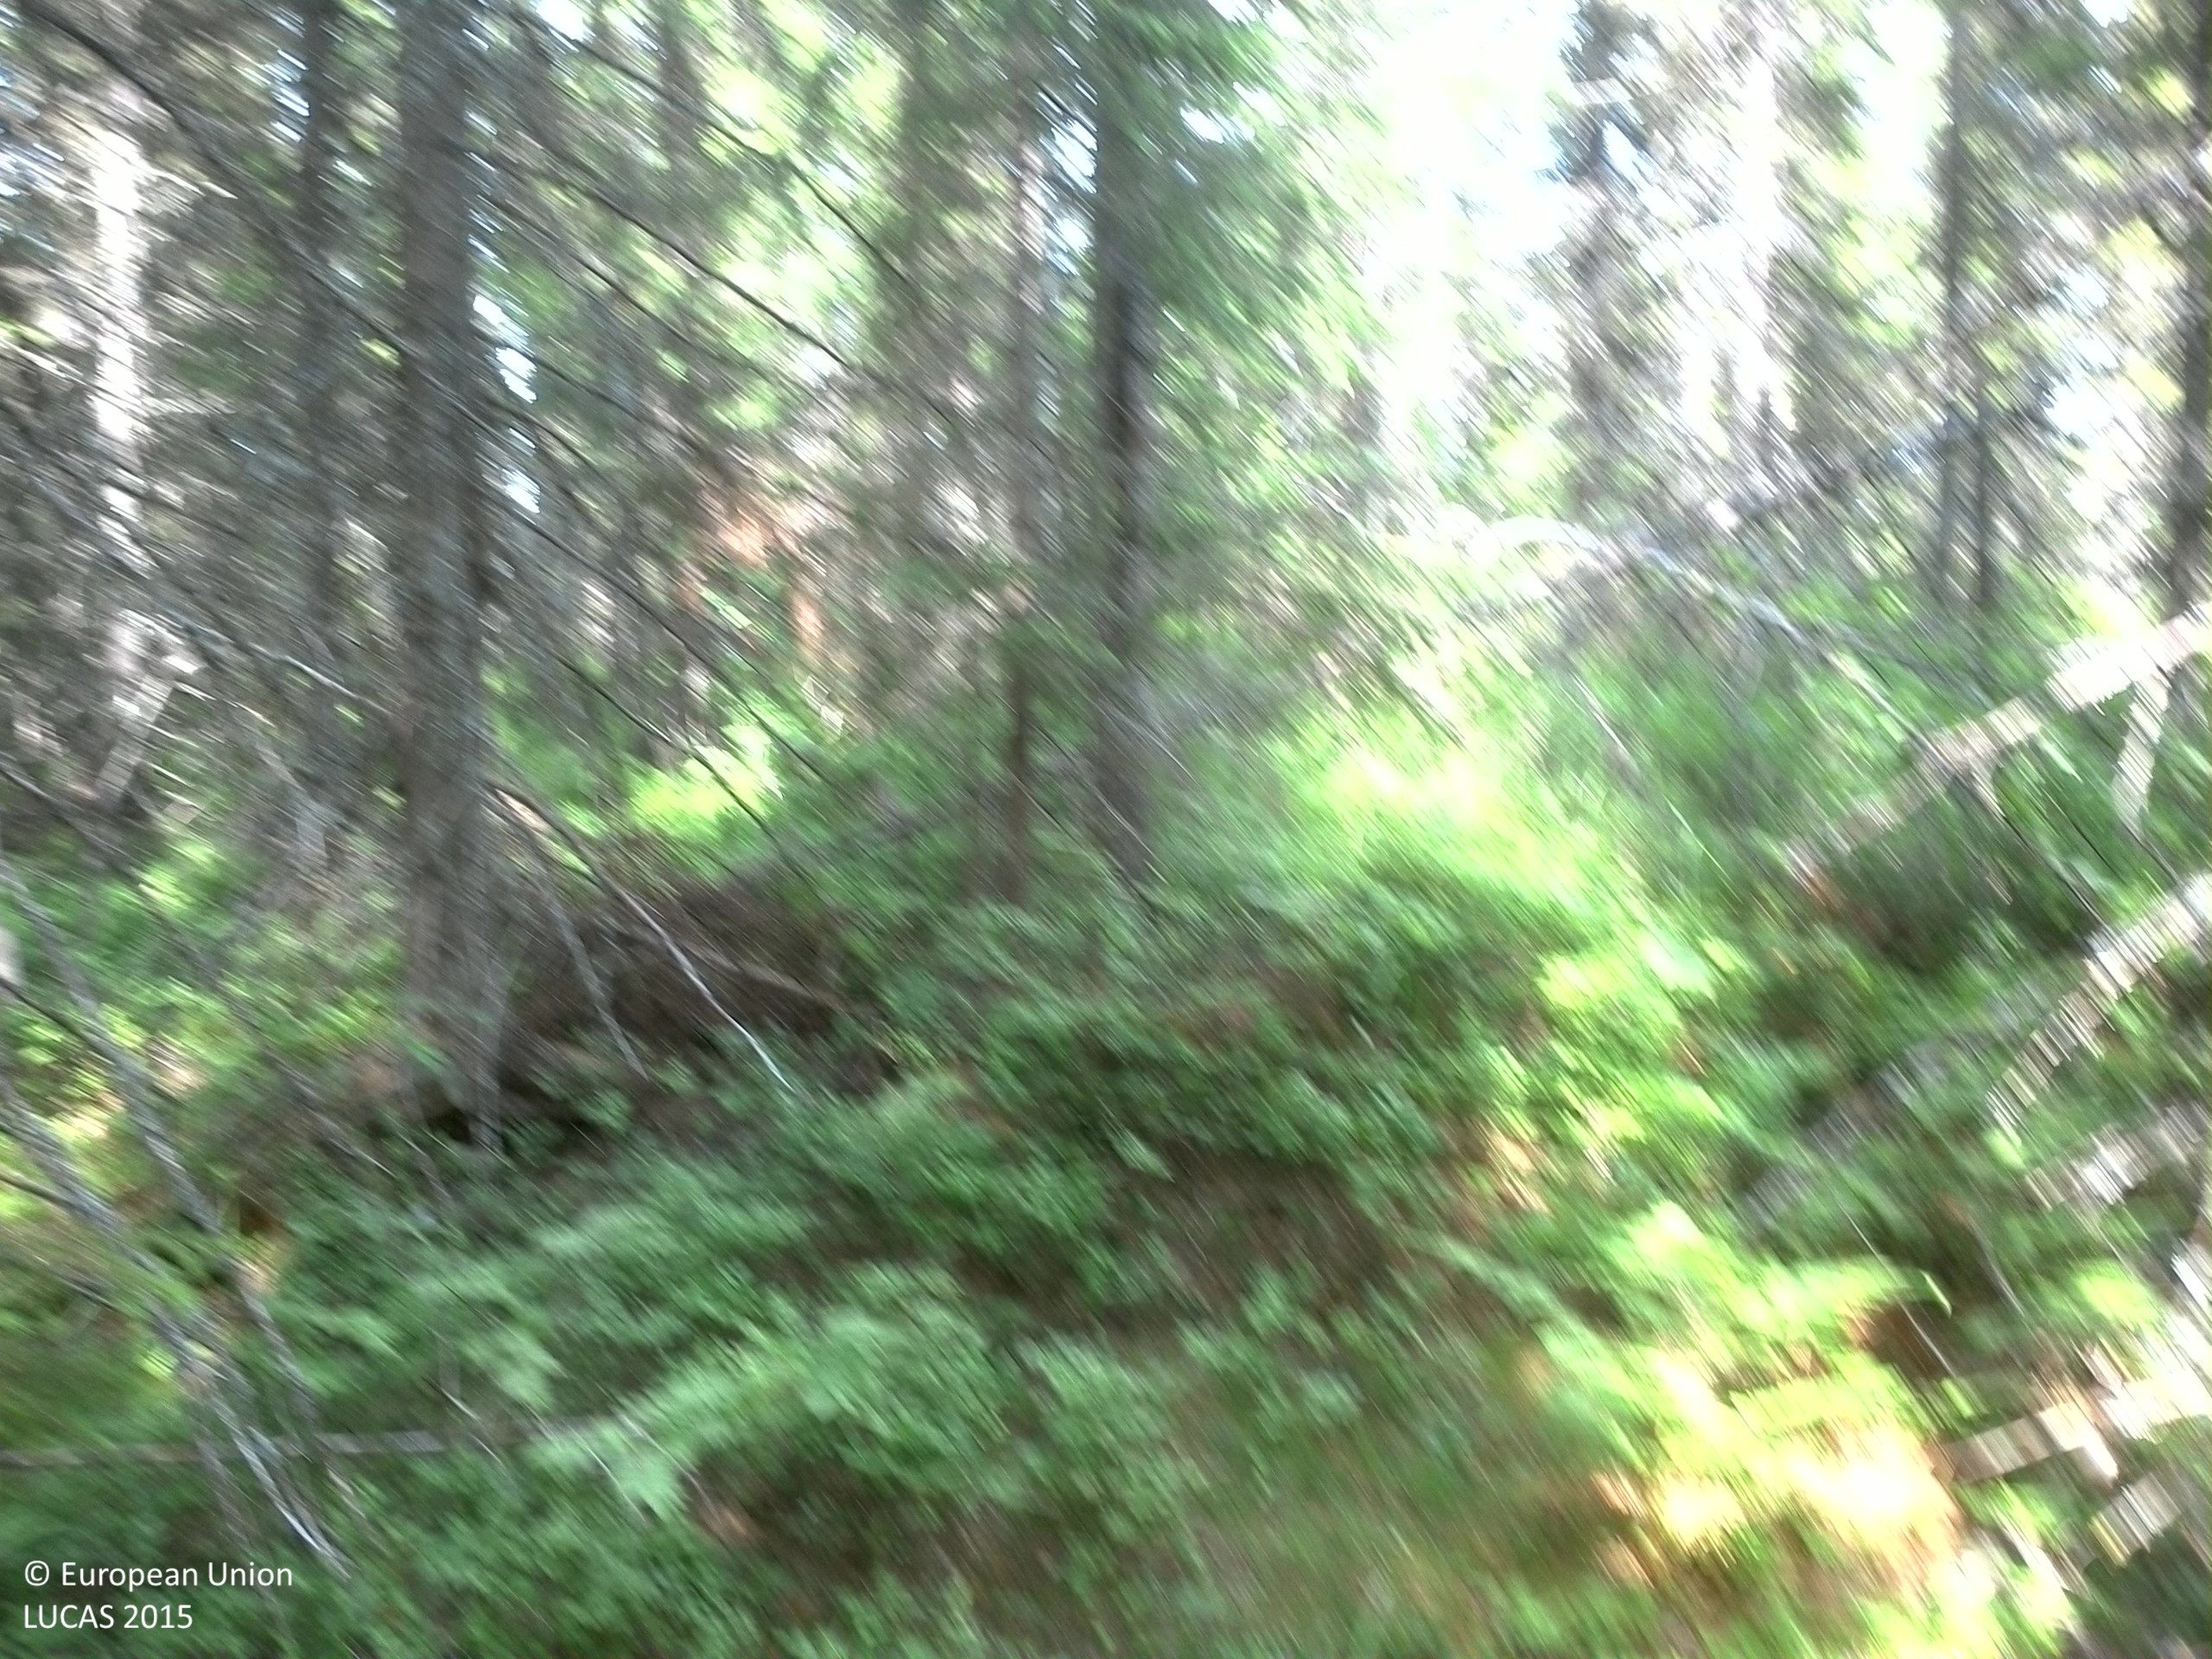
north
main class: Woodland
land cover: Spruce dominated mixed woodland
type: boreal forest
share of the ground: > 75 %
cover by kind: coniferous forest trees 50 %, broadleaved forest trees 25 %, shrubs 20 %, herbaceous plants 5 %
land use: Forestry
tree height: > 5 m
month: July
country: SE
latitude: 62.8166
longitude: 17.6502
